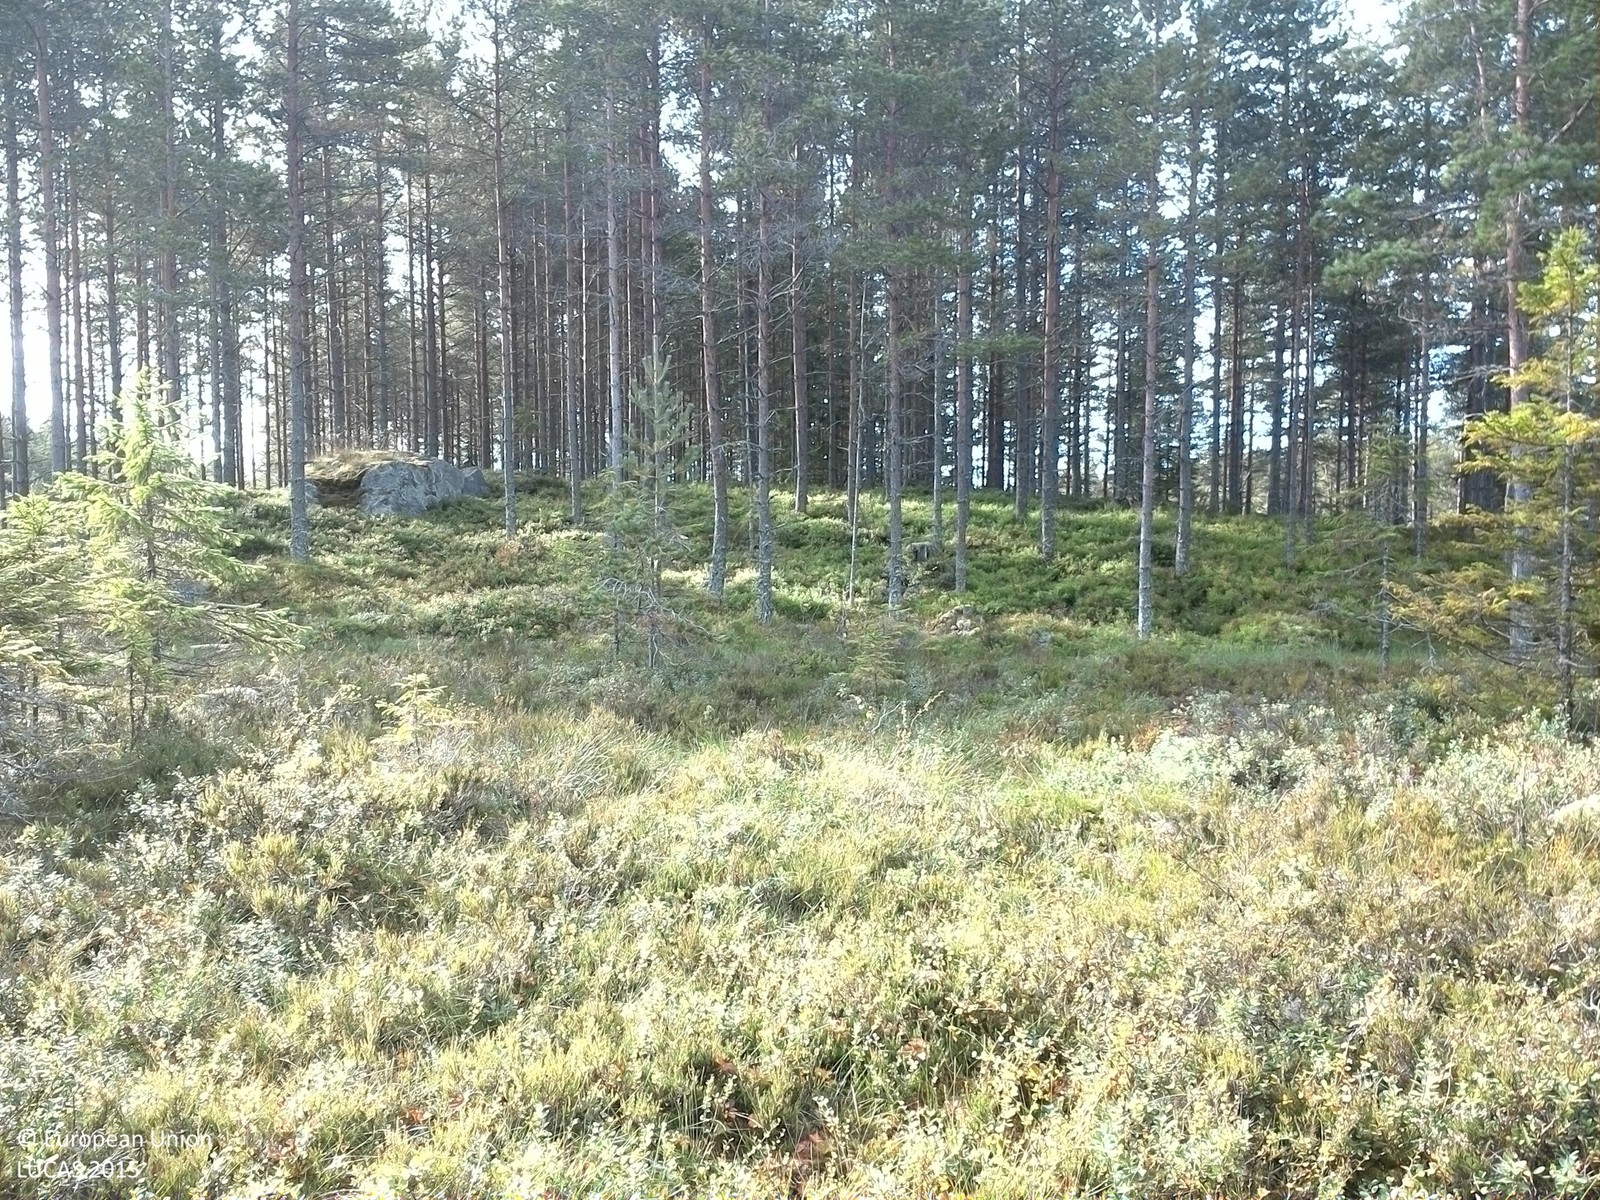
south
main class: Woodland
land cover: Pine dominated coniferous woodland
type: boreal forest
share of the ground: 25 - 50 %
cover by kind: coniferous forest trees 40 %, shrubs 25 %, lichens and mosses 20 %, broadleaved forest trees 10 %, herbaceous plants 5 %
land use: Forestry
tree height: < 5 m
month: September
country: SE
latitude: 59.9601
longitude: 13.3758
